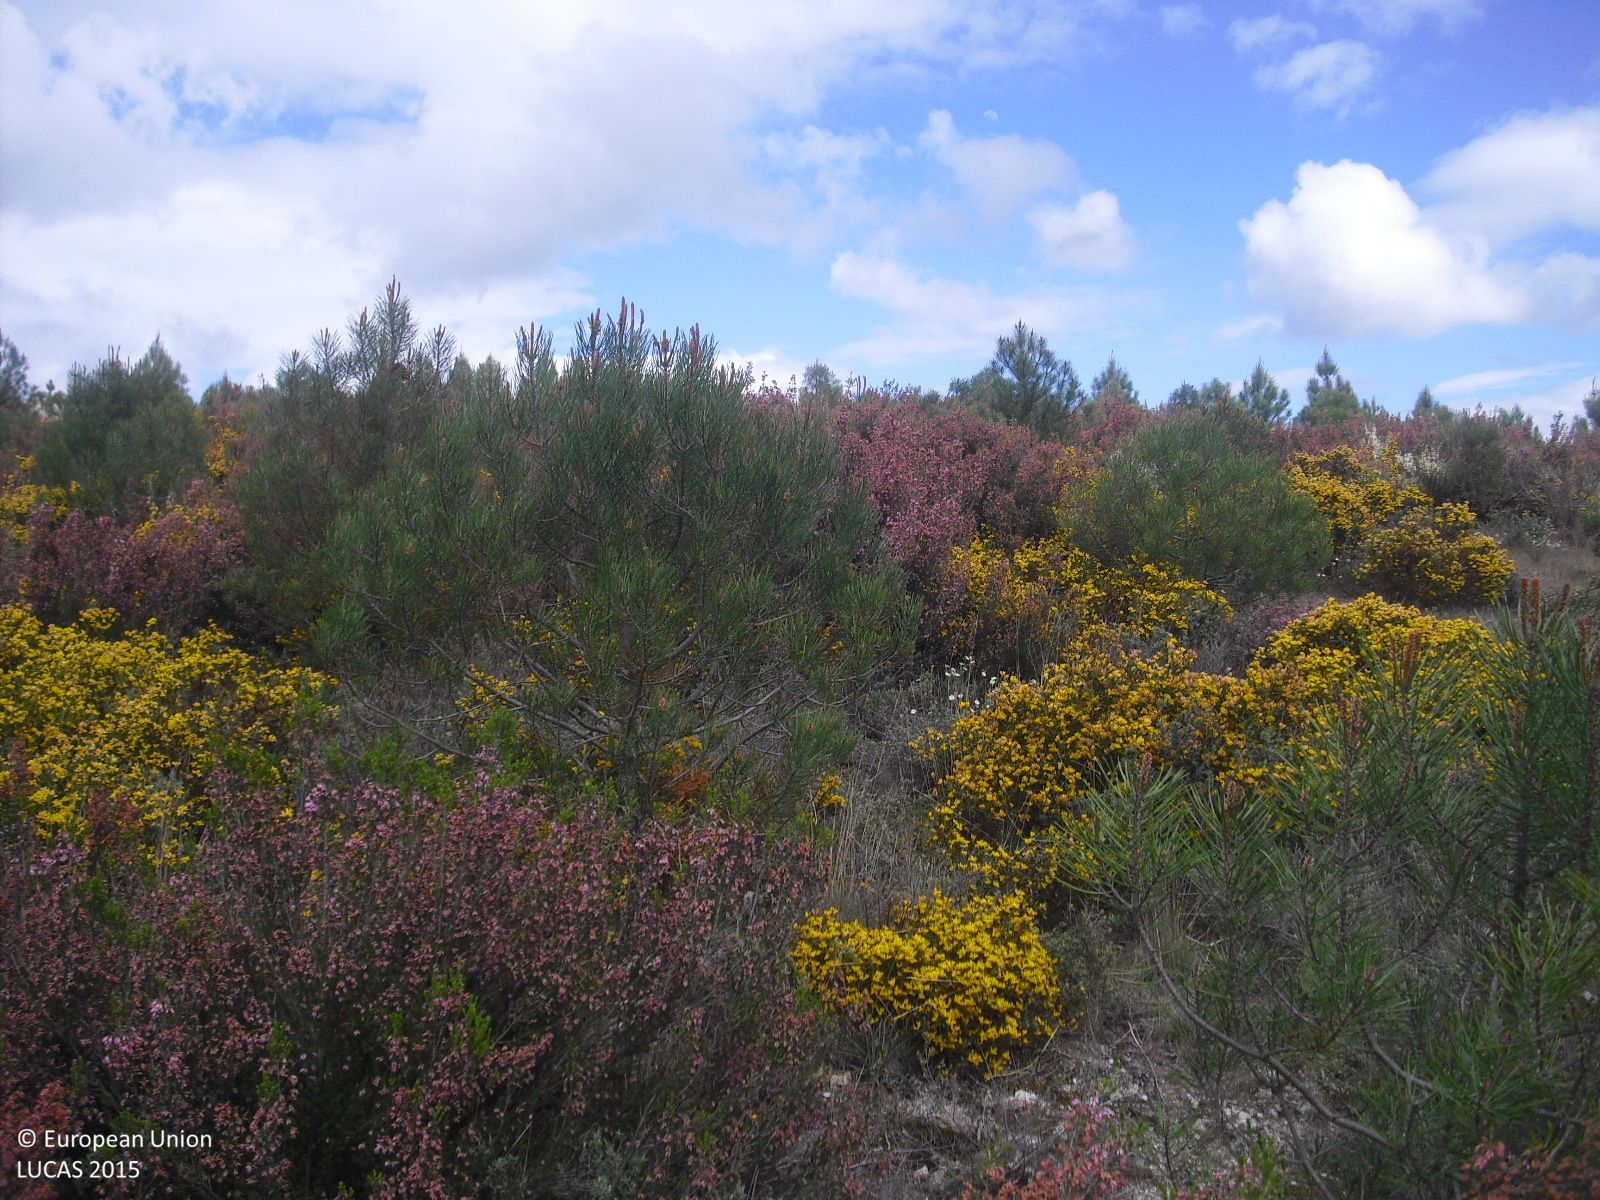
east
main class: Woodland
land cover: Pine dominated coniferous woodland
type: exotic forest
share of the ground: 10 - 25 %
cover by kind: shrubs 50 %, coniferous forest trees 30 %, herbaceous plants 15 %, consolidated bare surface 5 %
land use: Forestry
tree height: < 5 m
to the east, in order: Pine dominated coniferous woodland
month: April
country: ES
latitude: 41.8348
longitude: -7.6078
